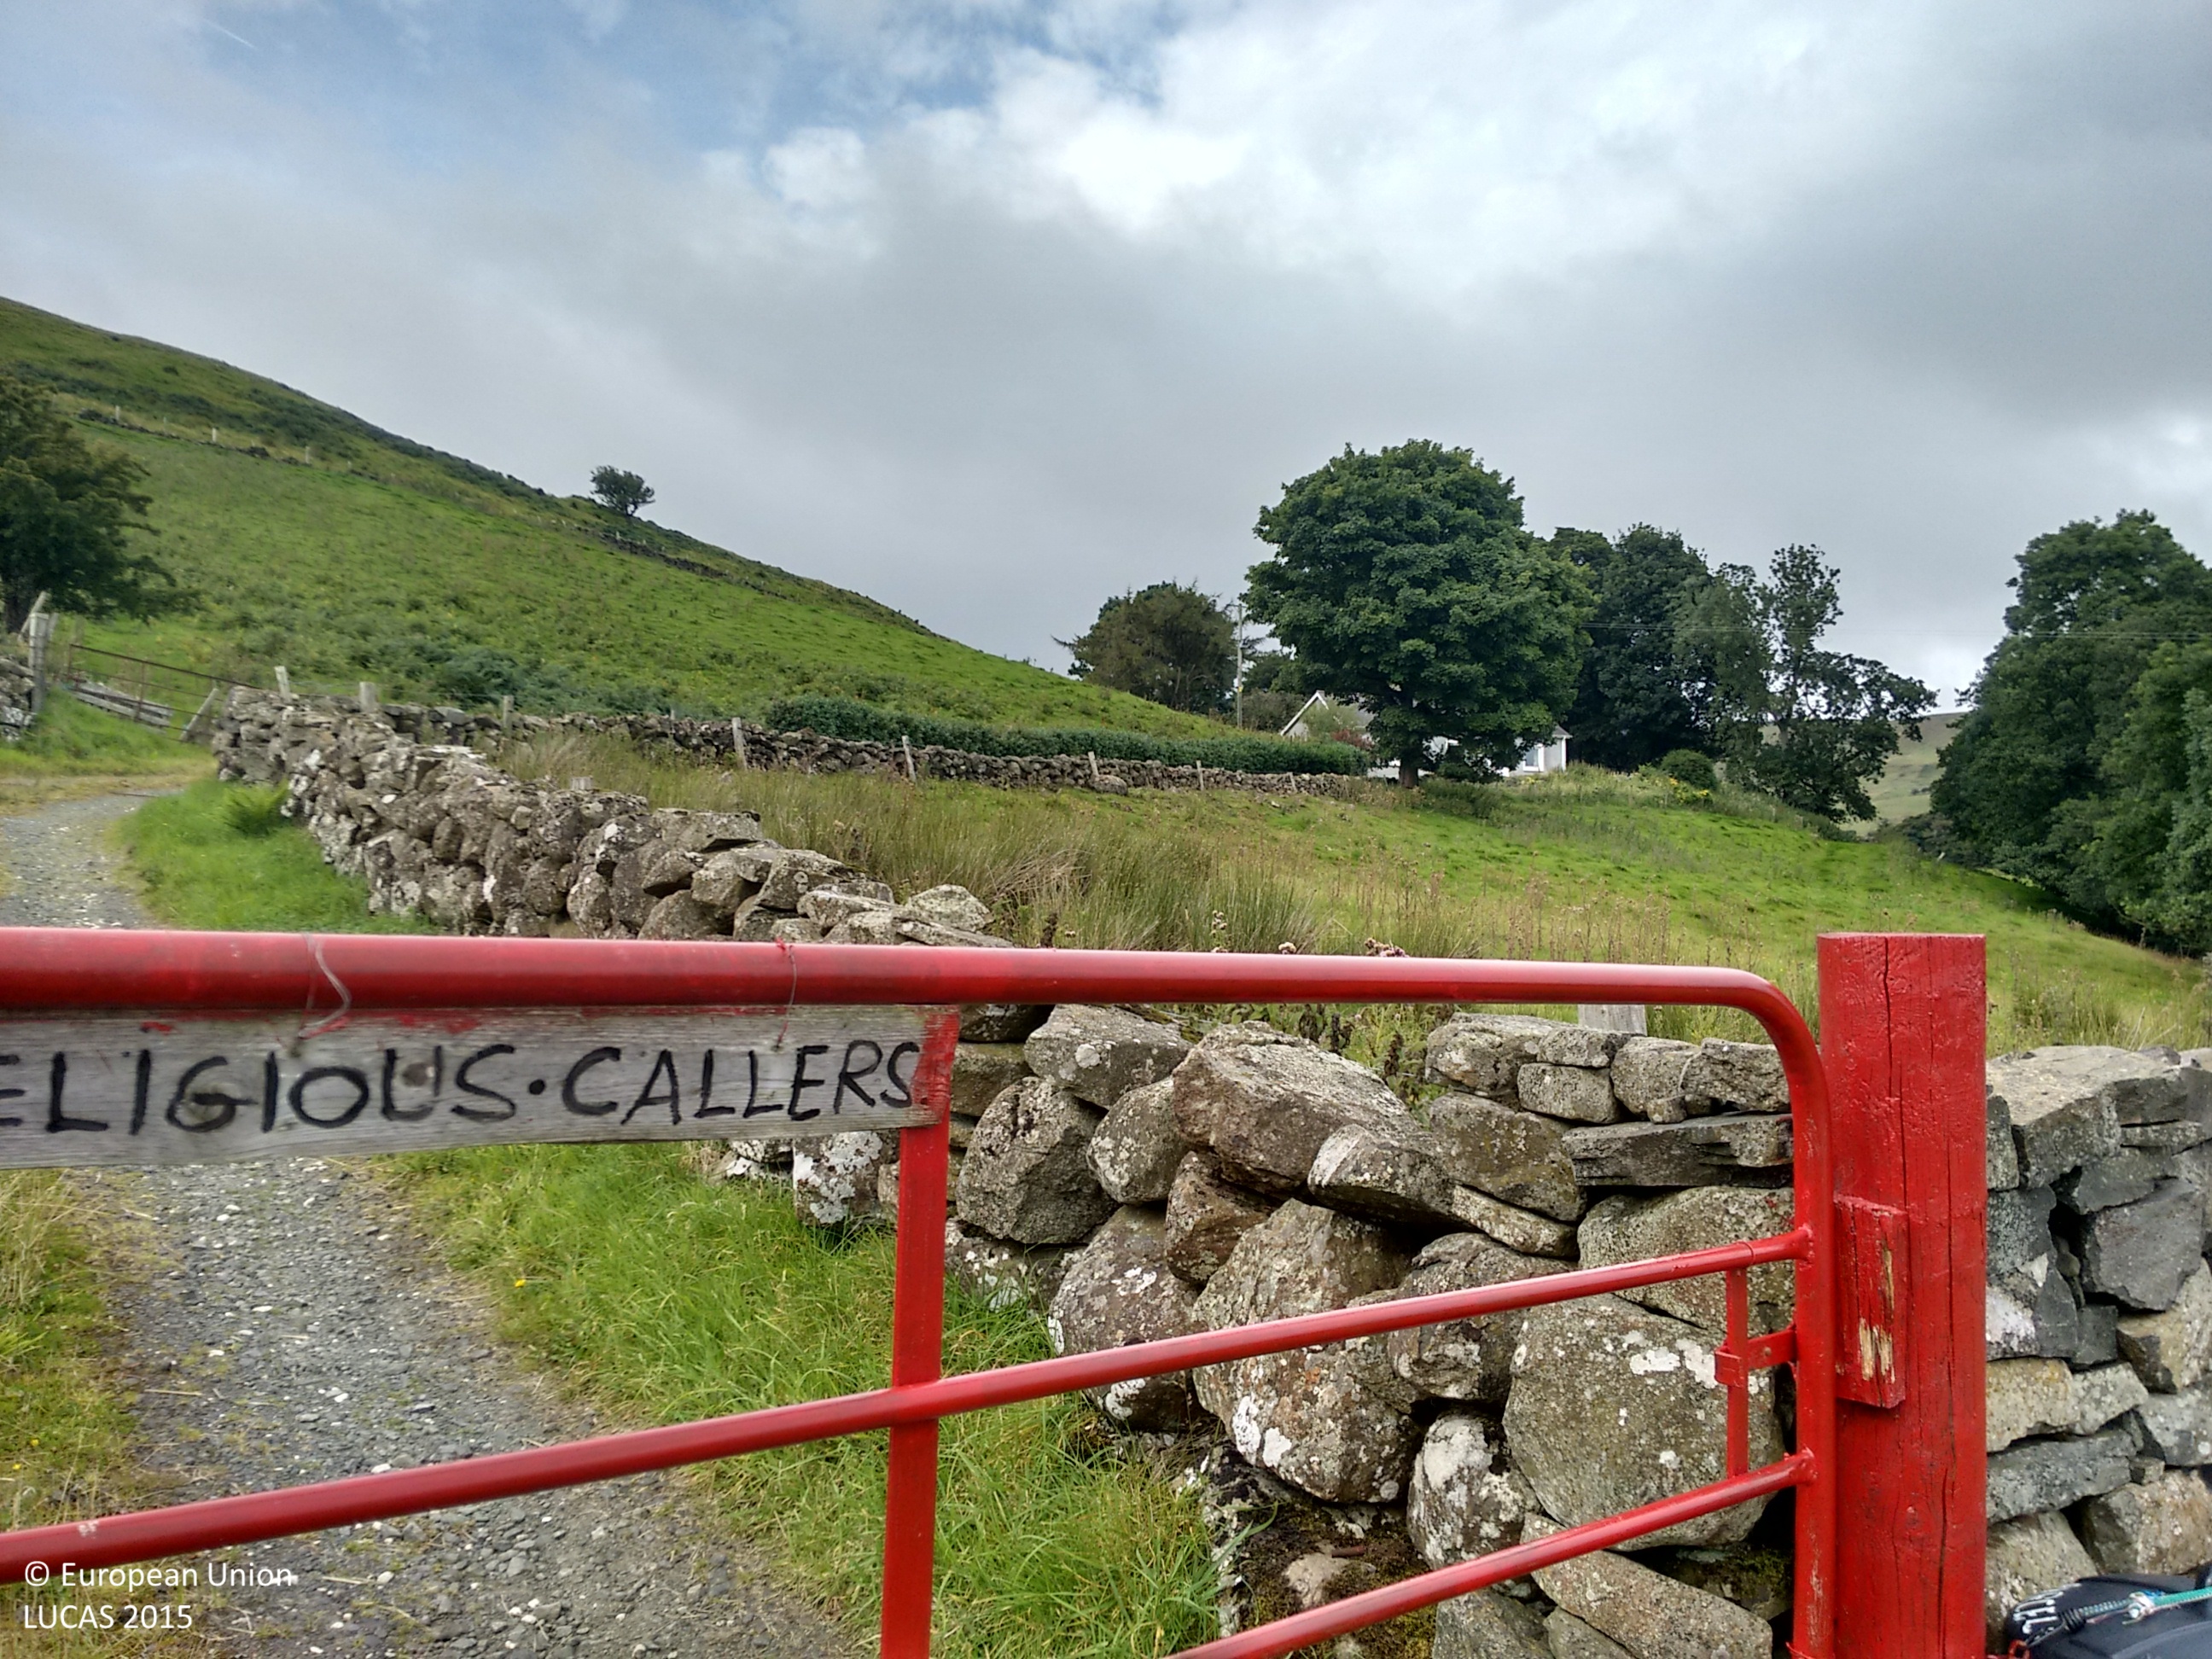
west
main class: Grassland
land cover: Grassland without tree/shrub cover
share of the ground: > 75 %
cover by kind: herbaceous plants 100 %
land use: Agriculture (excluding fallow land and kitchen gardens)
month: September
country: GB
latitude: 54.8929
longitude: -5.9000
